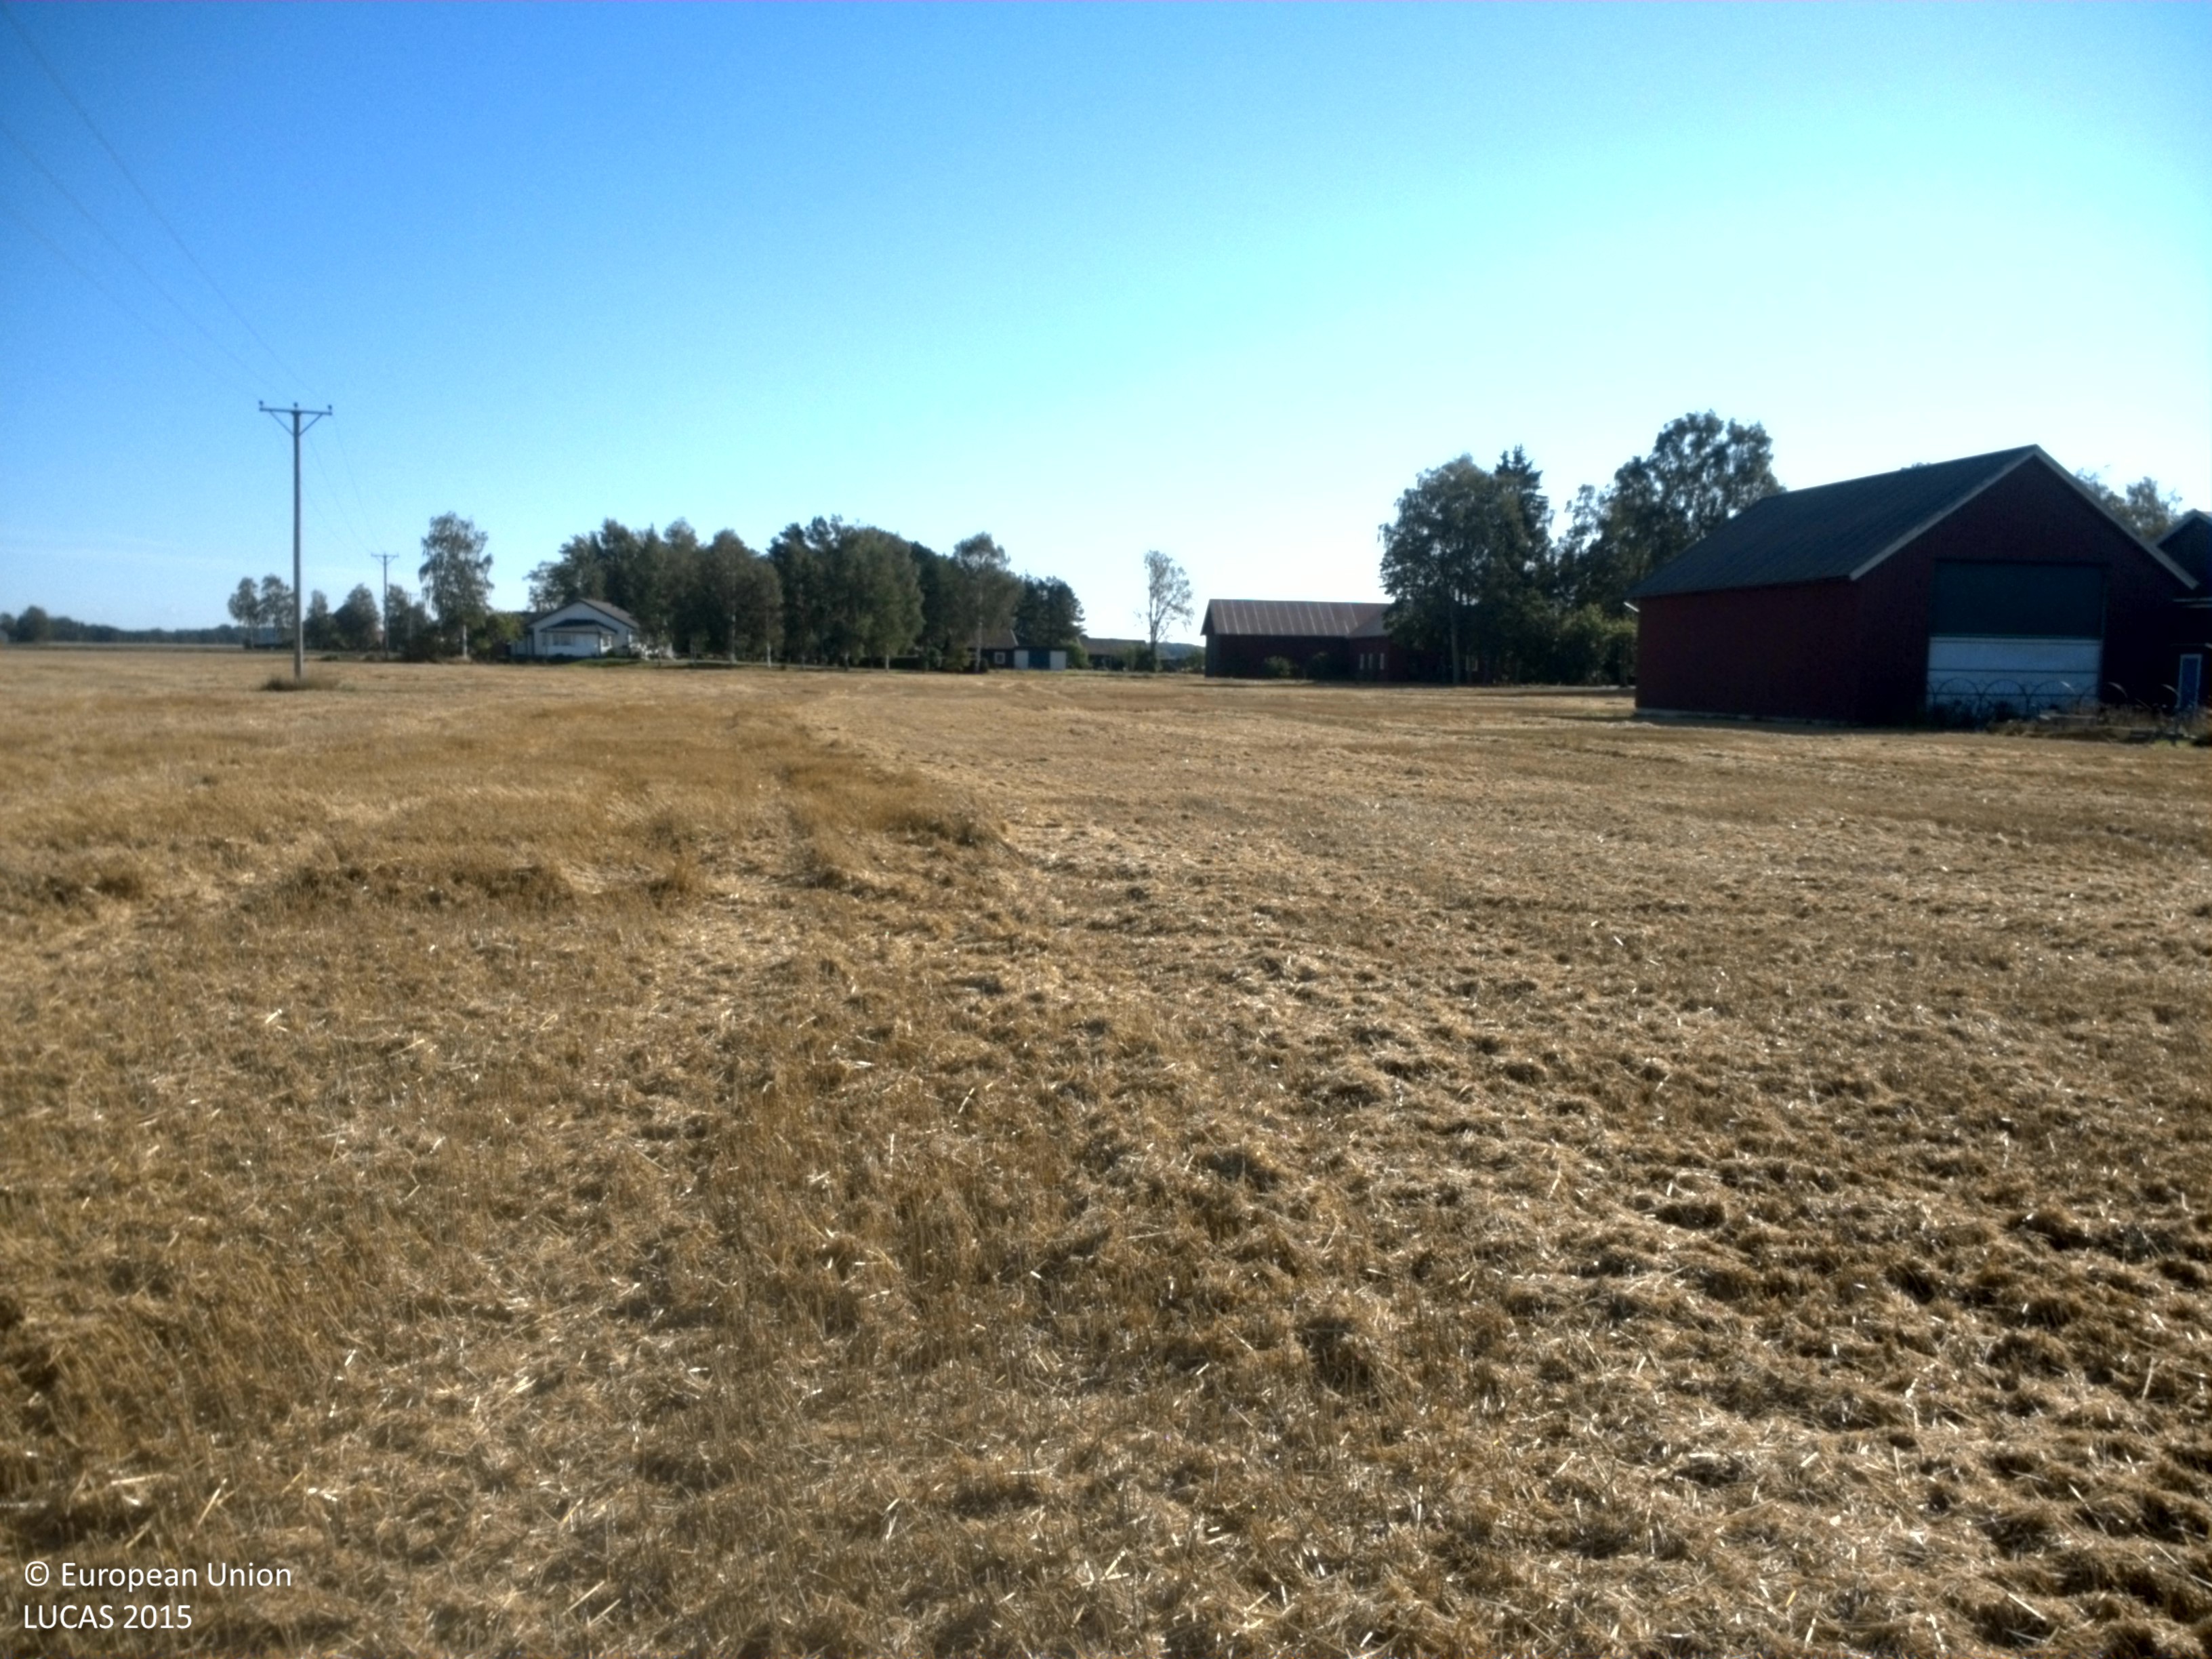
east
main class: Cropland
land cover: Common wheat
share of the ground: 50 - 75 %
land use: Agriculture (excluding fallow land and kitchen gardens)
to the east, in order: Common wheat; Grass margins; Managed hedges; Paved roads, cycling and walking lanes; Grass margins; Common wheat; Artificial constructions in urban areas
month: September
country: SE
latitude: 58.3968
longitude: 13.2279
